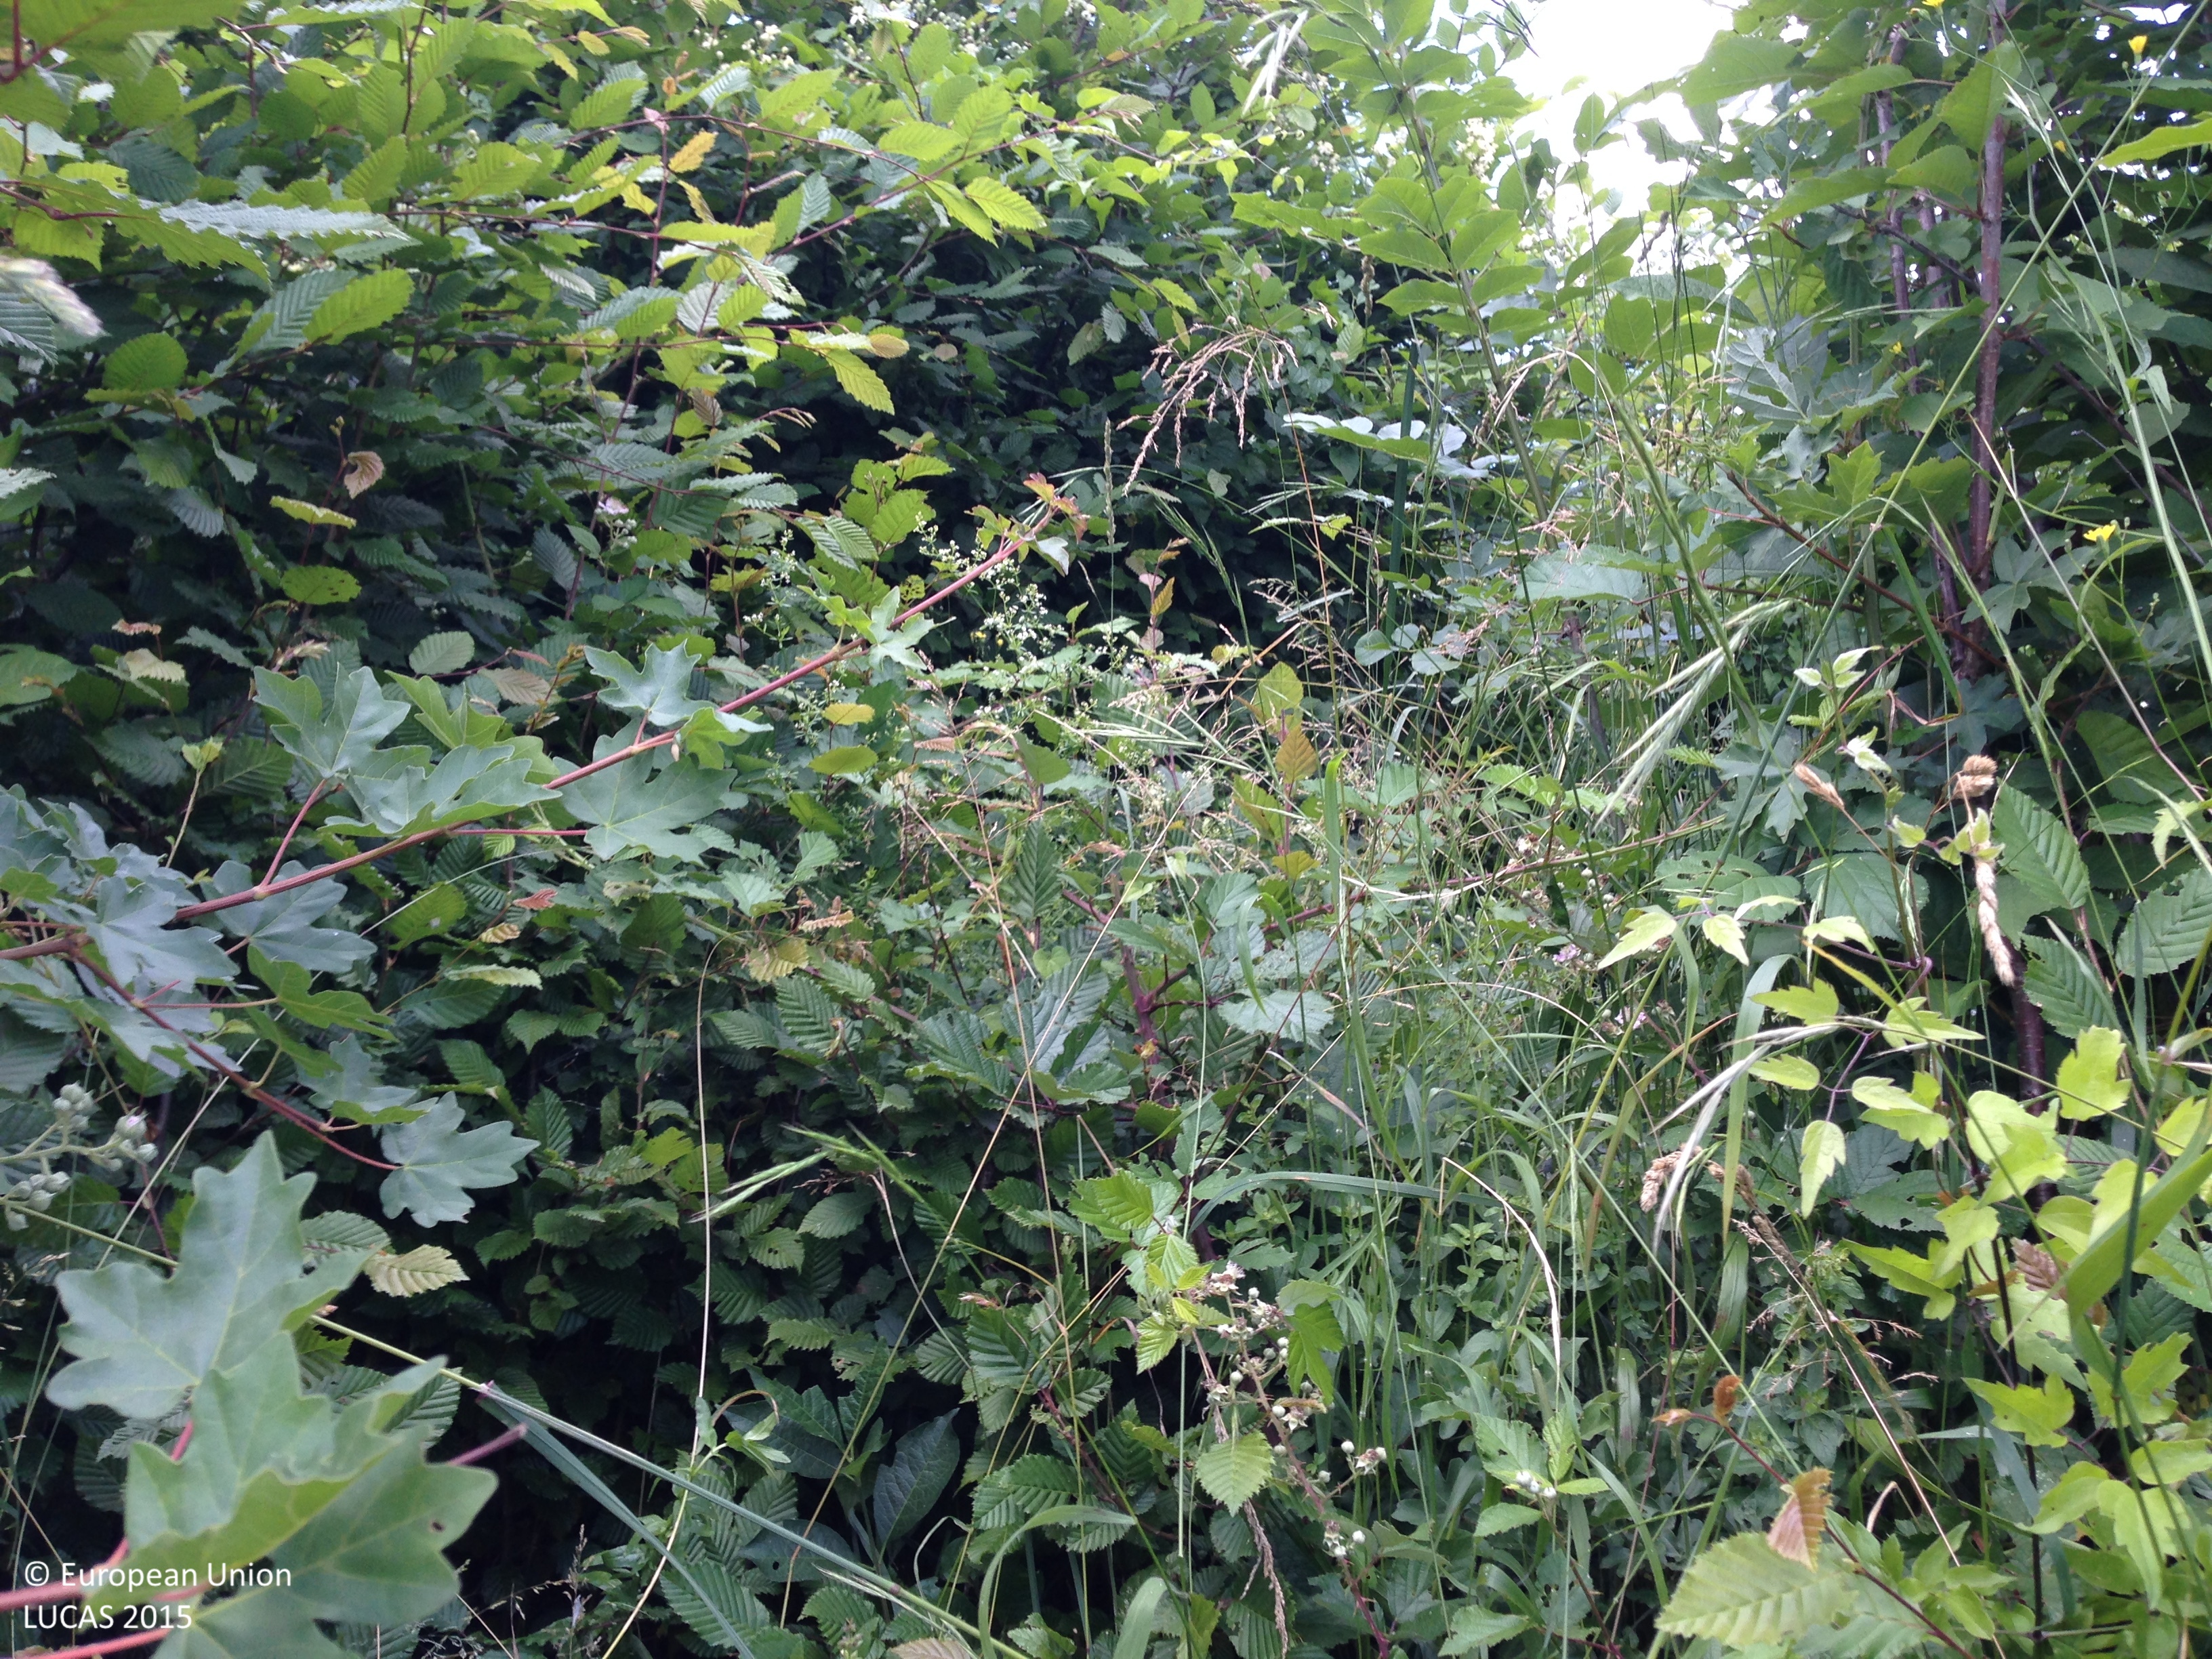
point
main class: Woodland
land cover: Broadleaved woodland
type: thermophilous deciduous forest
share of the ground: 10 - 25 %
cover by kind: herbaceous plants 50 %, shrubs 30 %, broadleaved forest trees 15 %, unconsolidated bare surface 5 %
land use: Semi-natural and natural areas not in use
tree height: < 5 m
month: June
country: HR
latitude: 44.6479
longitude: 15.9836
